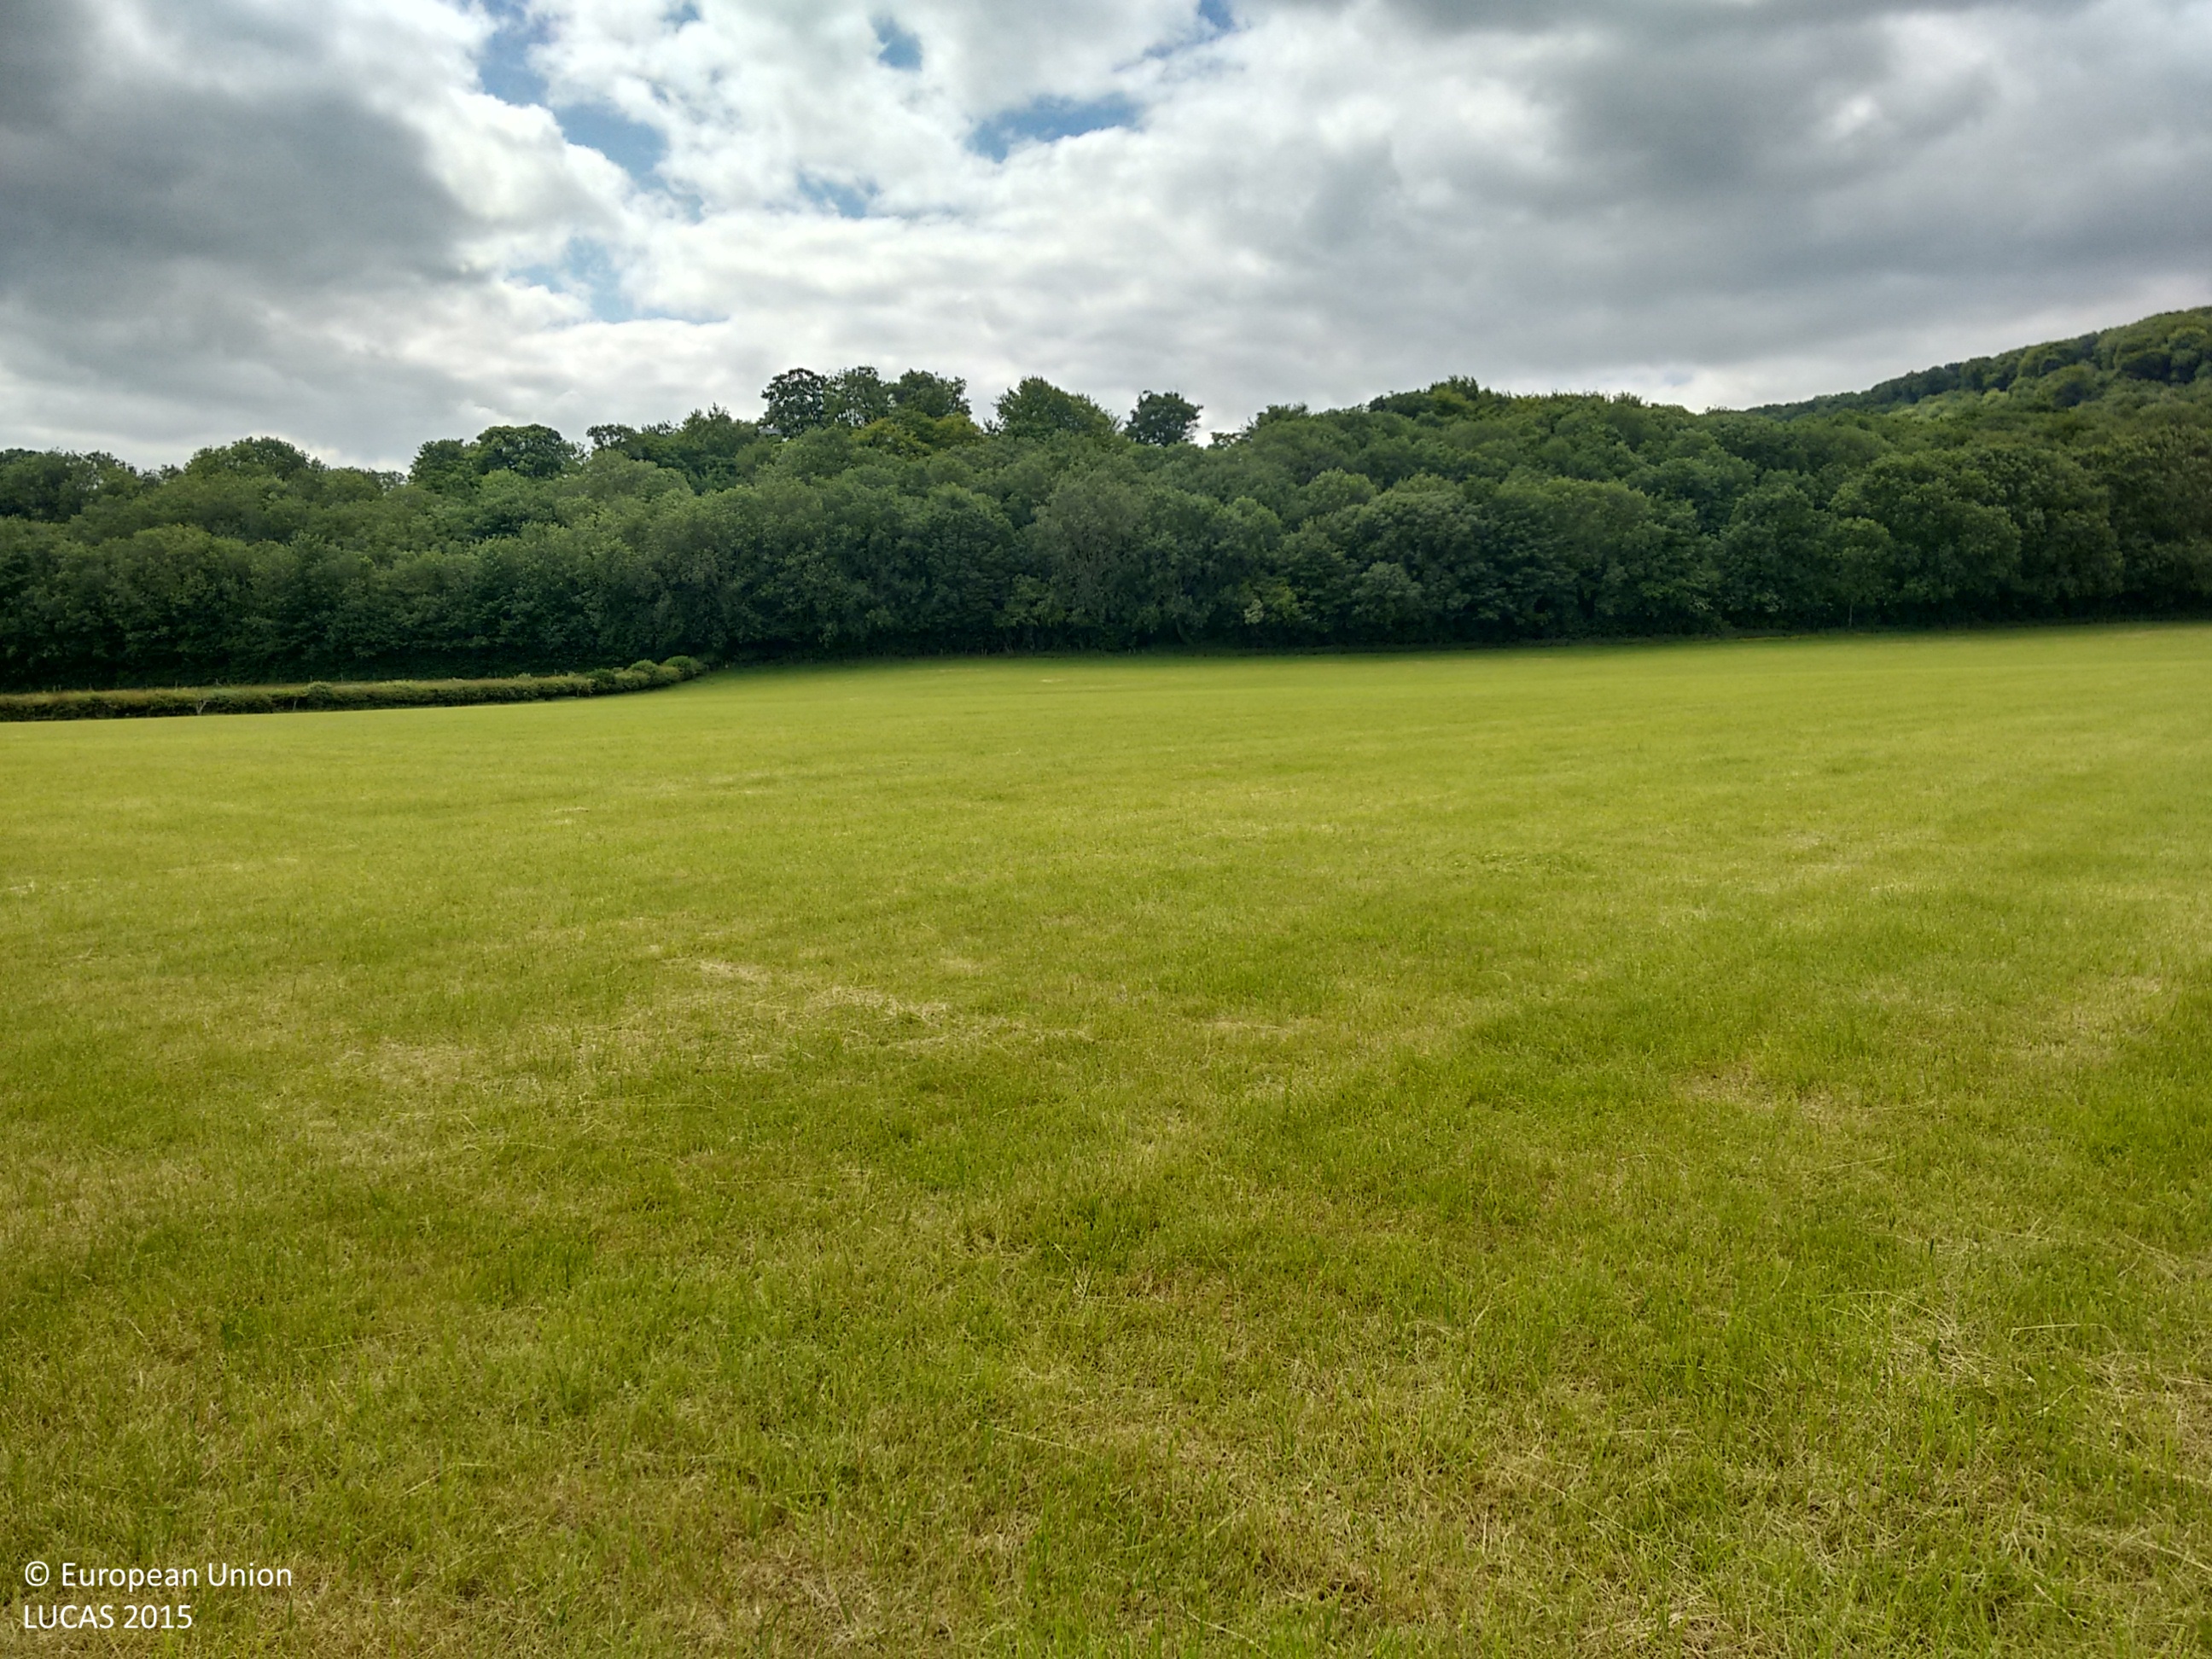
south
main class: Grassland
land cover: Grassland without tree/shrub cover
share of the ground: > 75 %
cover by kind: herbaceous plants 100 %
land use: Agriculture (excluding fallow land and kitchen gardens)
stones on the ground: < 10 %
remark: Harvested field
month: June
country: GB
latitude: 50.9007
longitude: -0.0292
